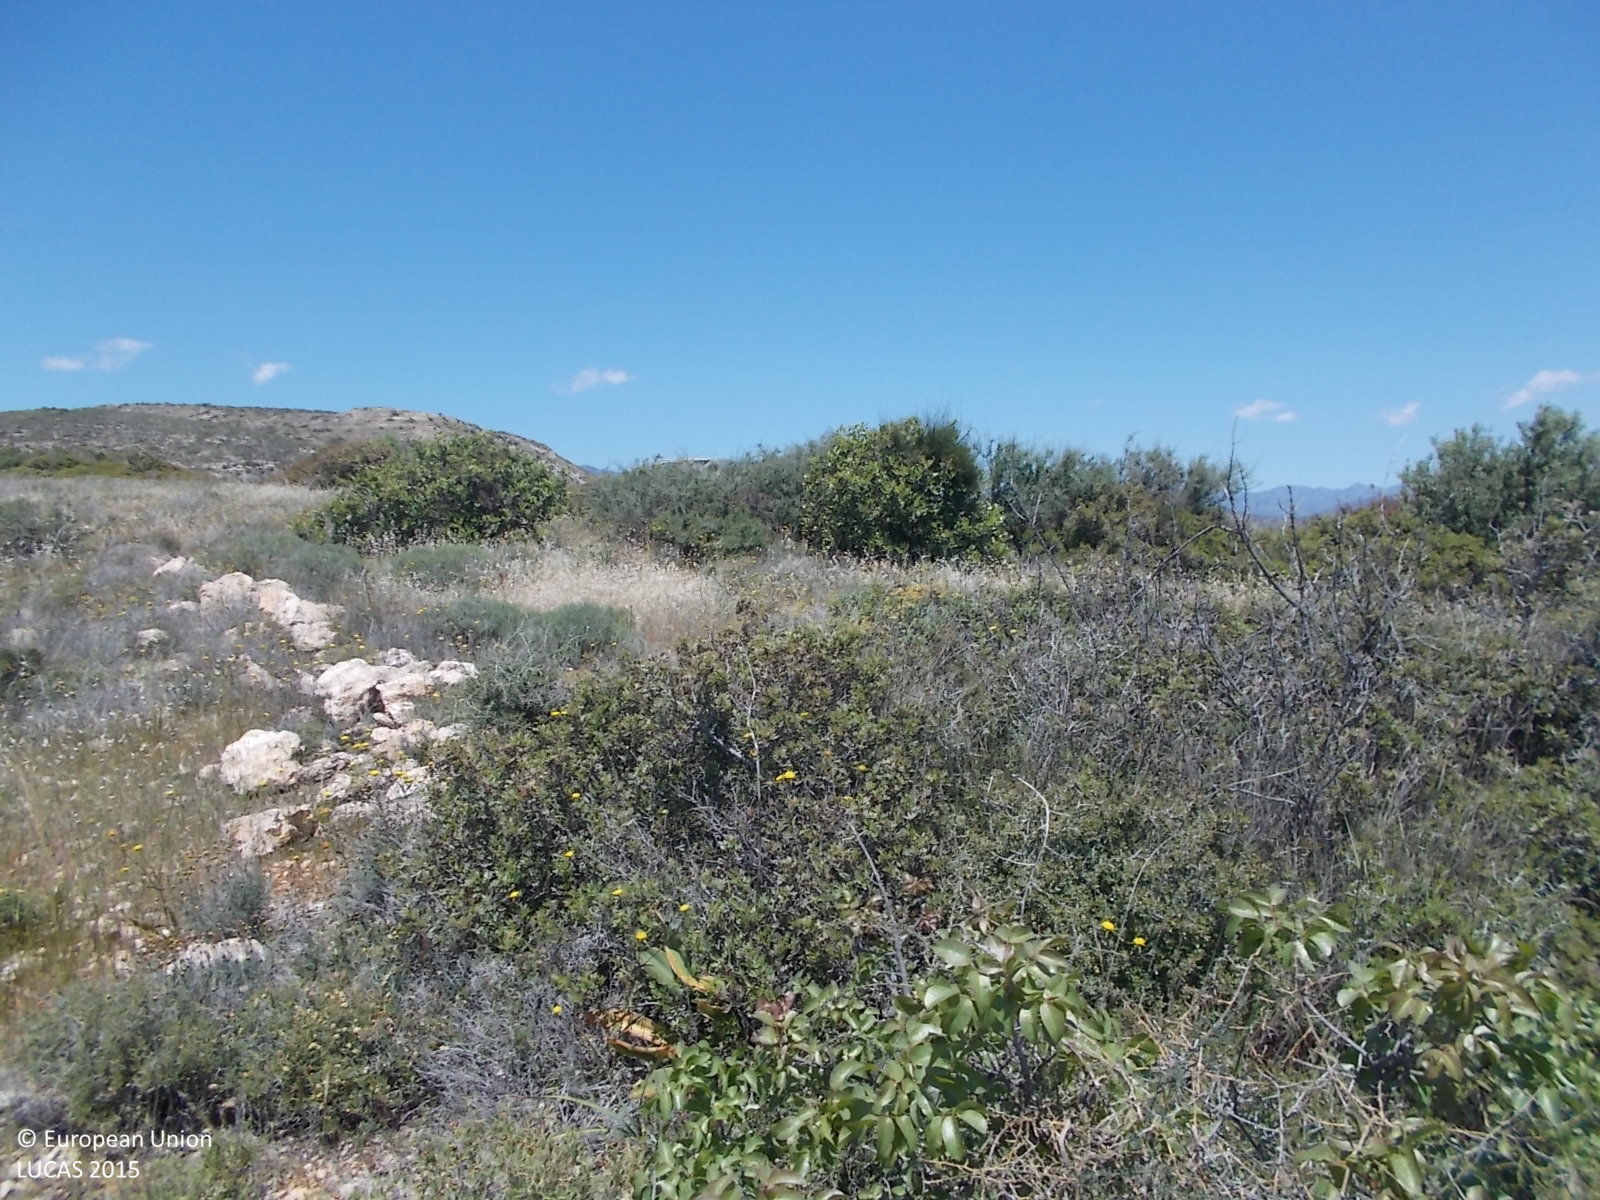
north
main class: Shrubland
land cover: Shrubland with sparse tree cover
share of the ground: 50 - 75 %
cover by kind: shrubs 65 %, herbaceous plants 15 %, unconsolidated bare surface 10 %, broadleaved forest trees 5 %, consolidated bare surface 5 %
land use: Semi-natural and natural areas not in use
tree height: < 5 m
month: April
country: CY
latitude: 34.7382
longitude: 33.0714
